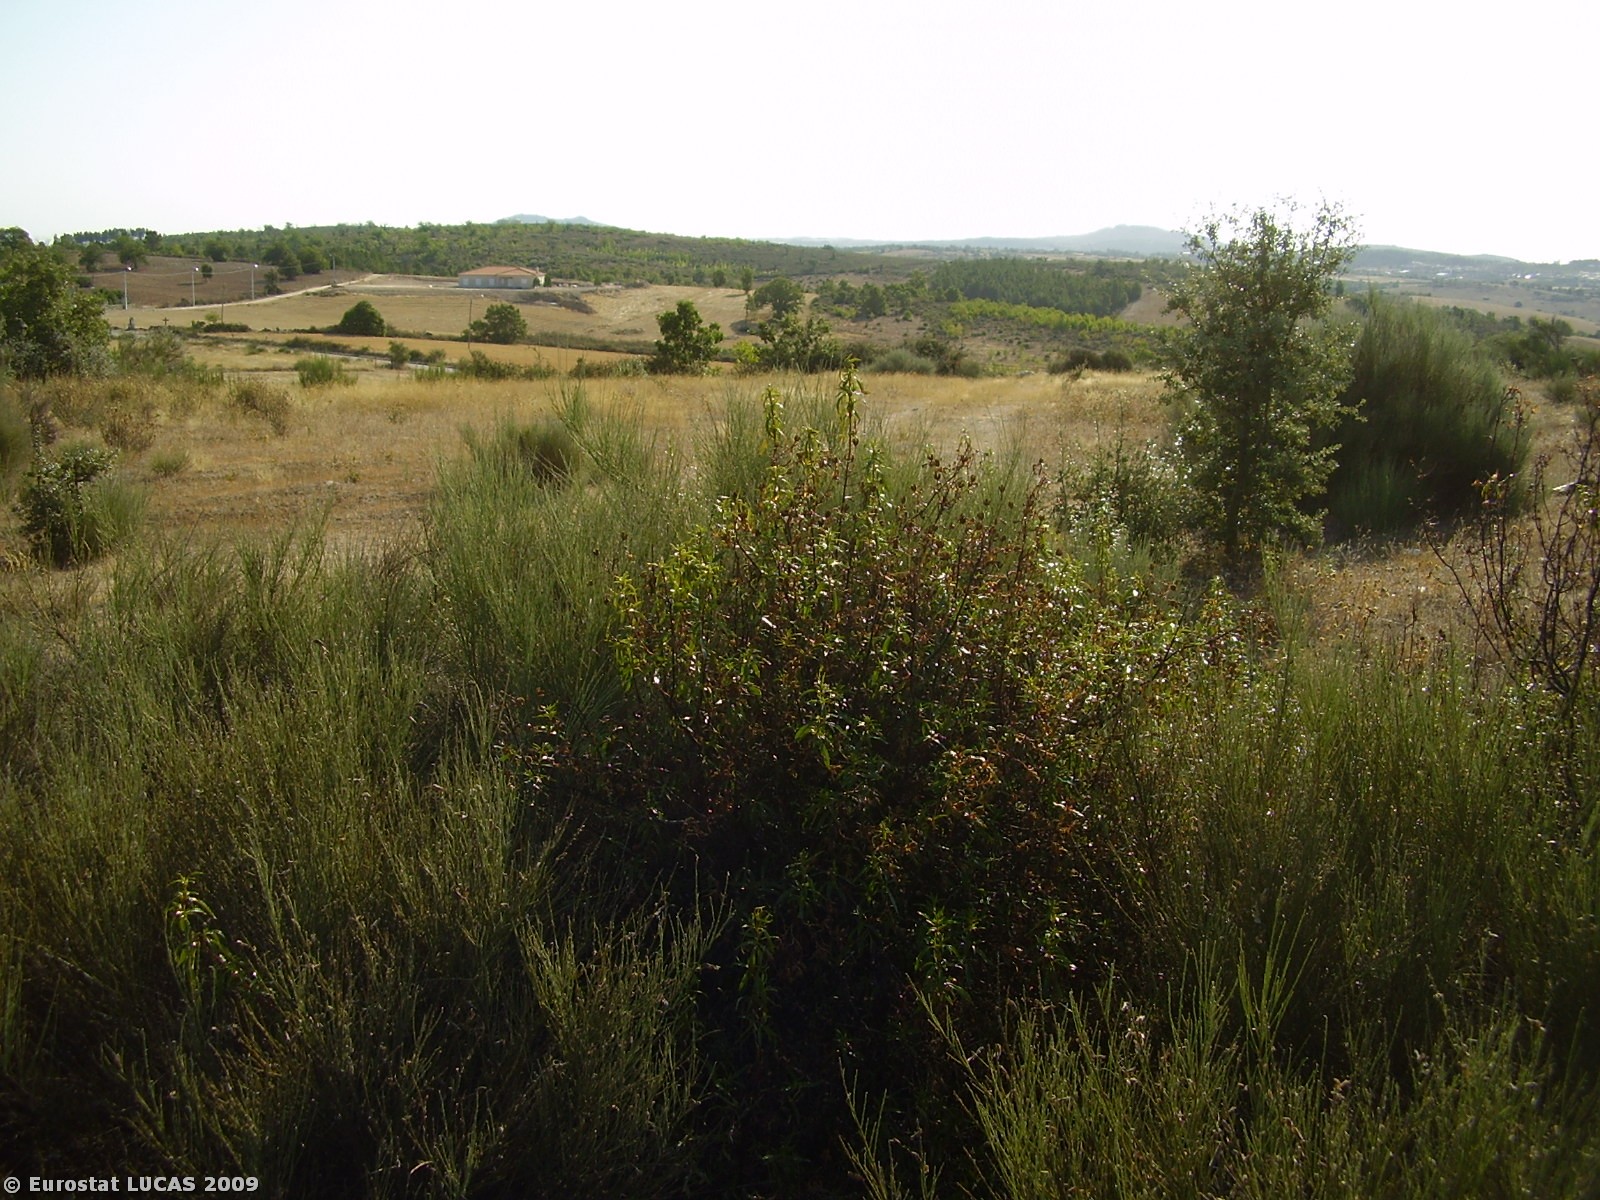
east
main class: Shrubland
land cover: Shrubland with sparse tree cover
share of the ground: > 75 %
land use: Fallow land
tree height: > 5 m
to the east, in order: Shrubland with sparse tree cover; Tracks; Shrubland with sparse tree cover; Spontaneously vegetated surfaces; Common wheat; Ditches and canals; Pear fruit; Grass margins; Rye; Electric lines; Rye
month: August
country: PT
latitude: 41.3567
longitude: -6.7573
